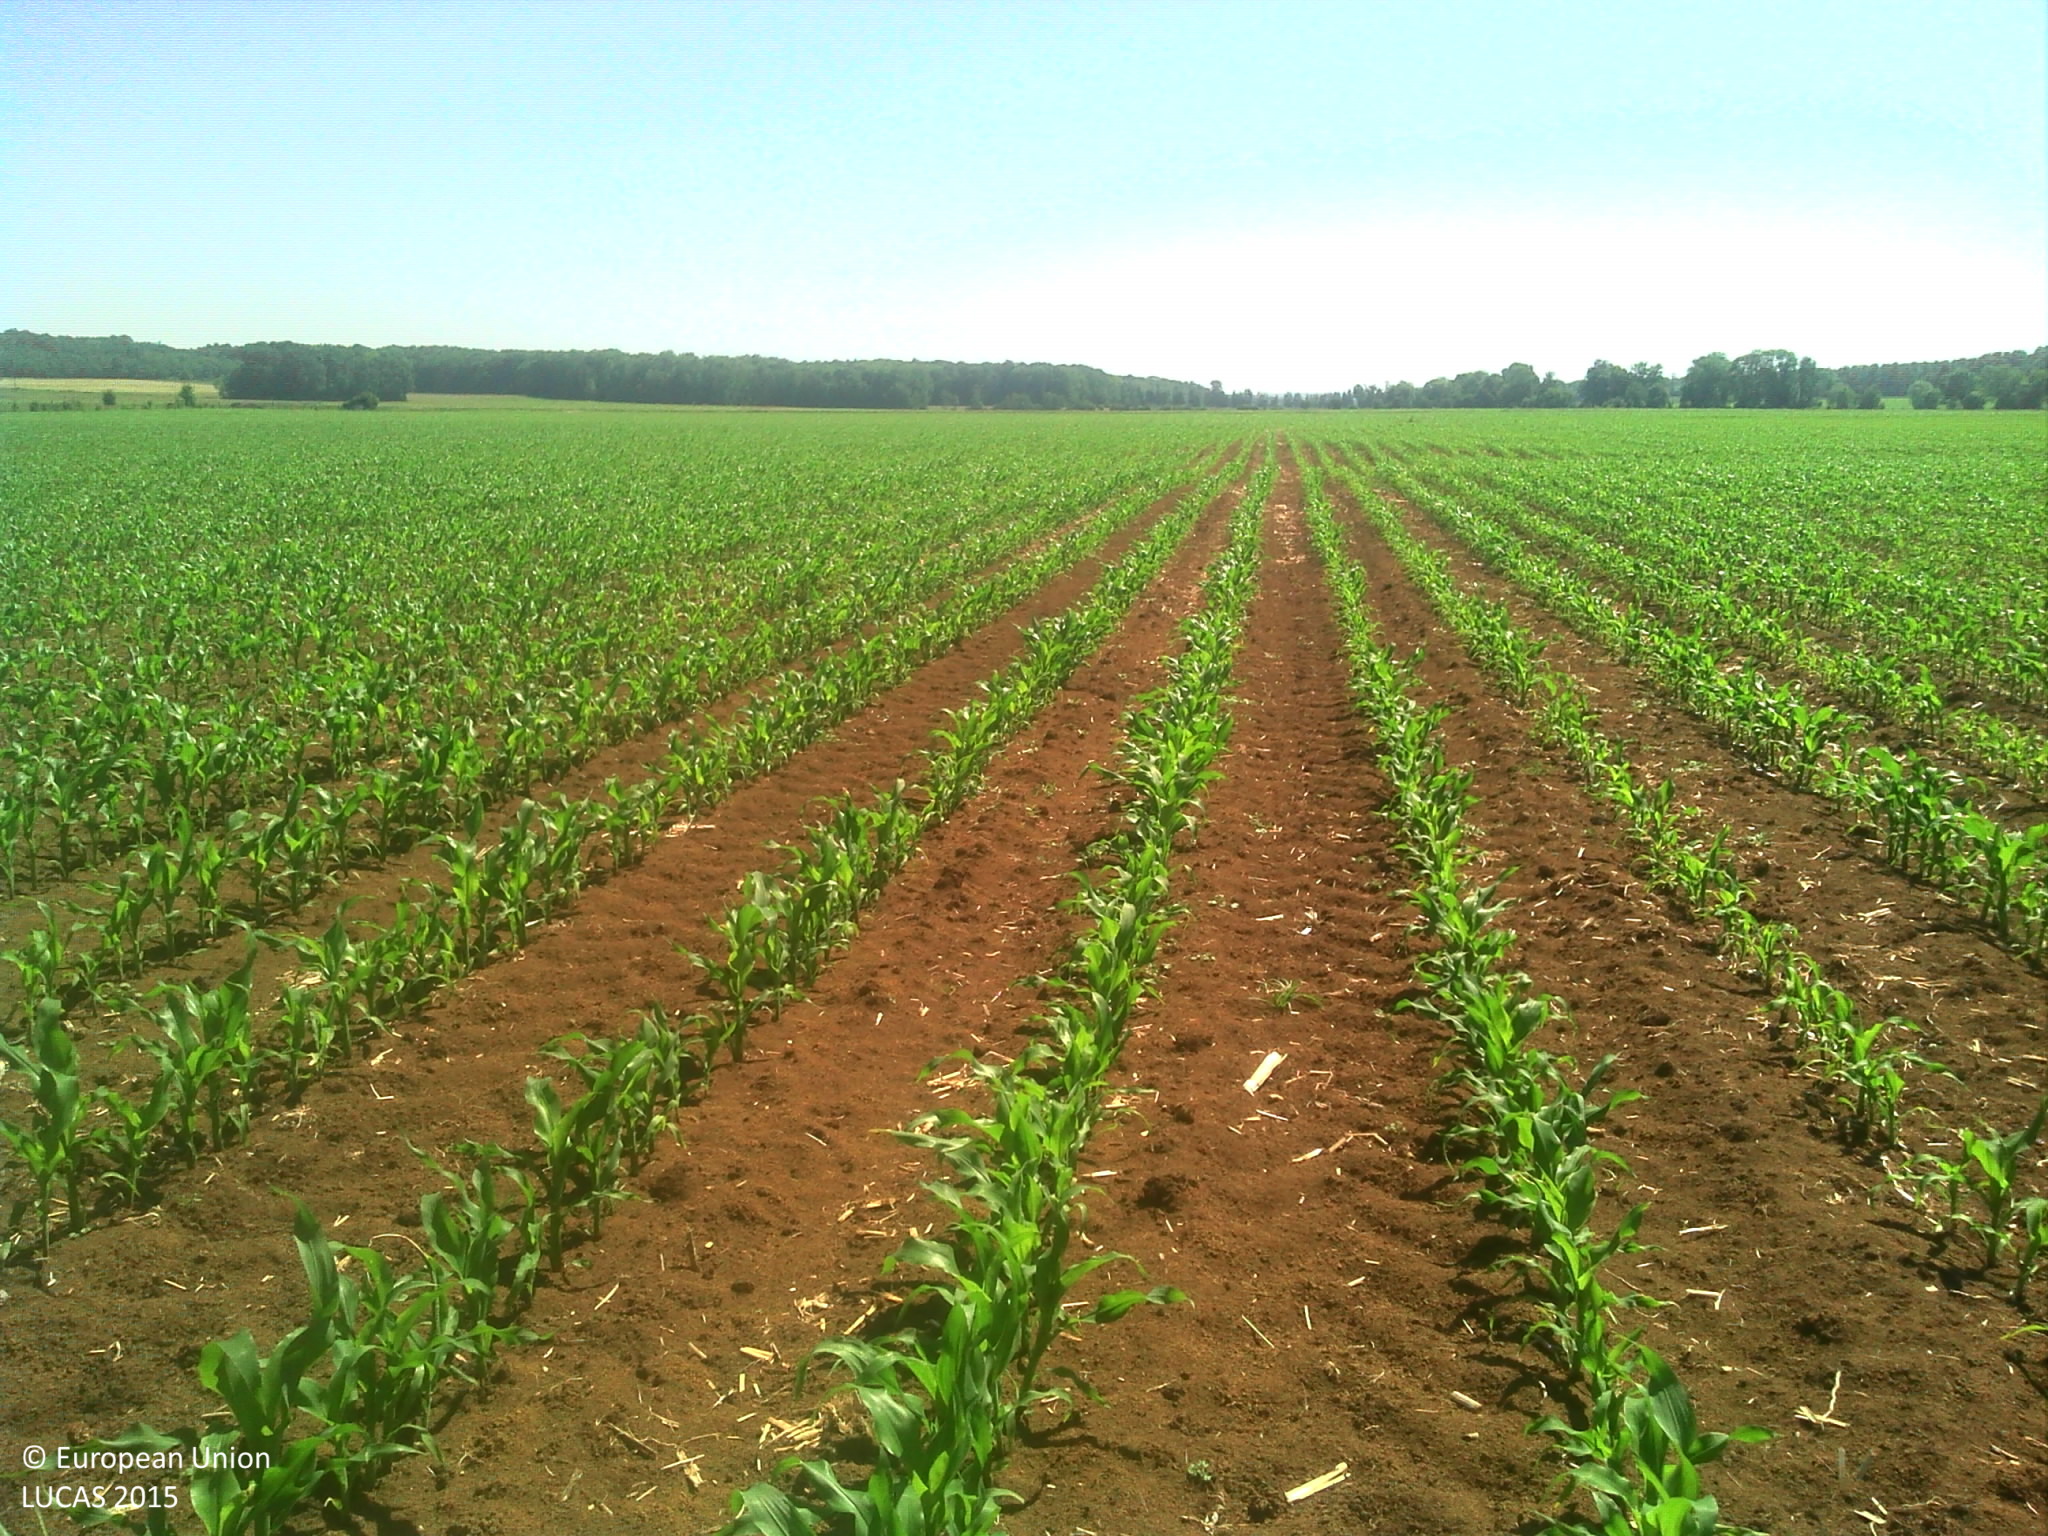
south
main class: Cropland
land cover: Maize
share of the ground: 10 - 25 %
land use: Agriculture (excluding fallow land and kitchen gardens)
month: June
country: FR
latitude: 48.4252
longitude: 4.7952
